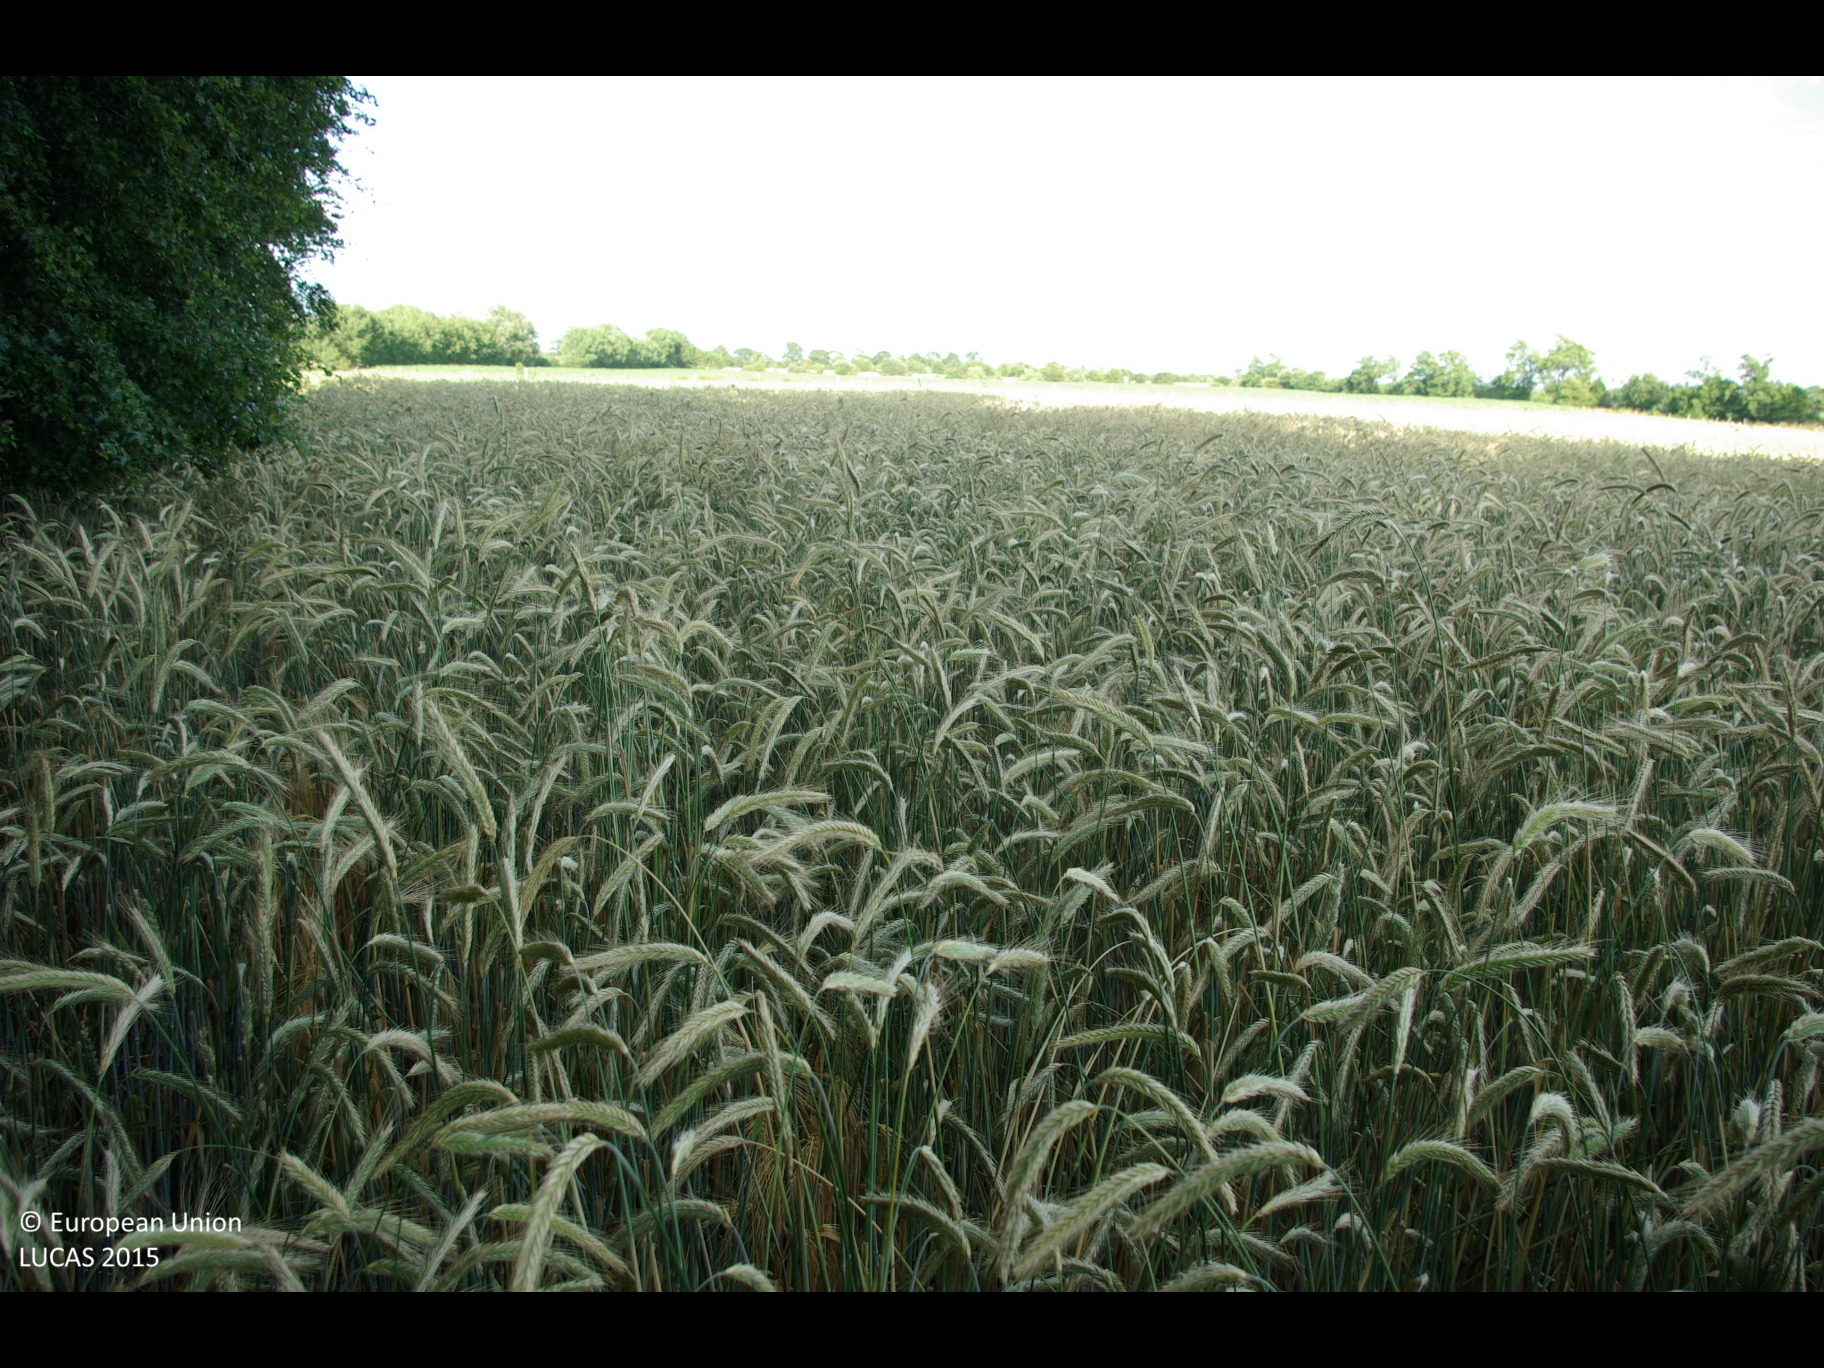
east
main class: Cropland
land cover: Rye
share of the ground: > 75 %
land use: Agriculture (excluding fallow land and kitchen gardens)
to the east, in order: Rye; Shruby margins; Fences; Grassland without tree/shrub cover; Fences; Shruby margins; Maize
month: July
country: DE
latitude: 54.7836
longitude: 9.2697
